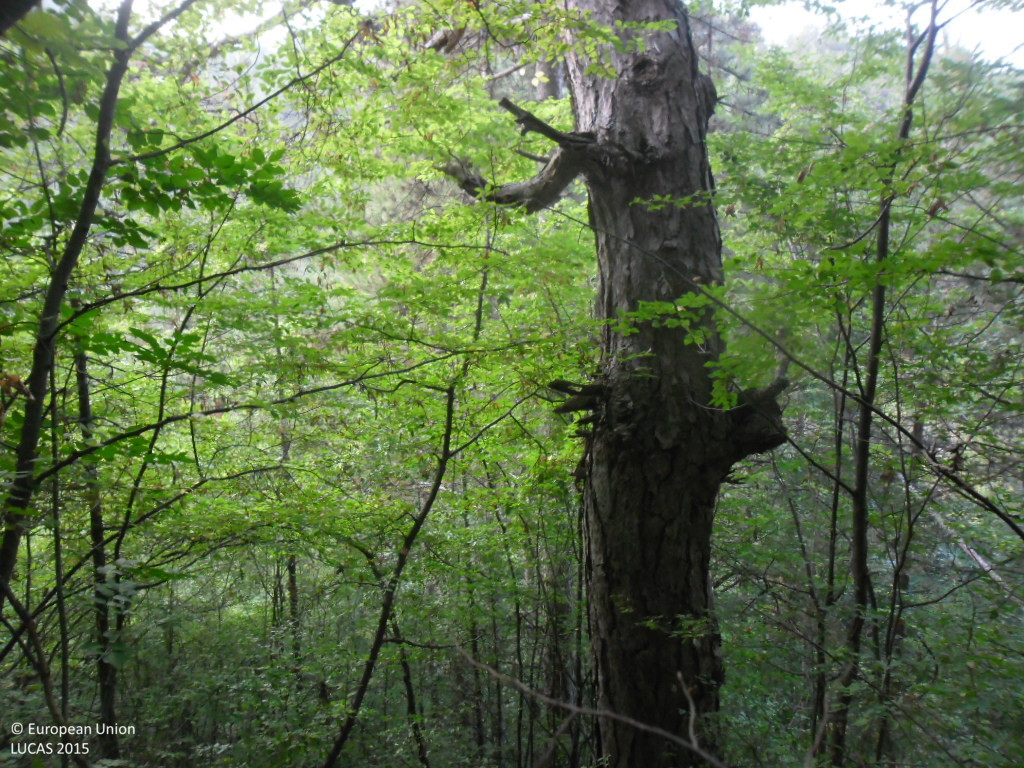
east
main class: Woodland
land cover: Pine dominated mixed woodland
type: hemiboreal forest and nemoral coniferous forest and mixed broadleaved-coniferous forest
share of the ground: > 75 %
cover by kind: coniferous forest trees 65 %, broadleaved forest trees 35 %
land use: Forestry
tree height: > 5 m
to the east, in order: Pine dominated mixed woodland; Broadleaved woodland; Pine dominated mixed woodland; Broadleaved woodland; Pine dominated coniferous woodland; Rivers and streams; Broadleaved woodland
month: September
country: BG
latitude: 41.8946
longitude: 22.9295
